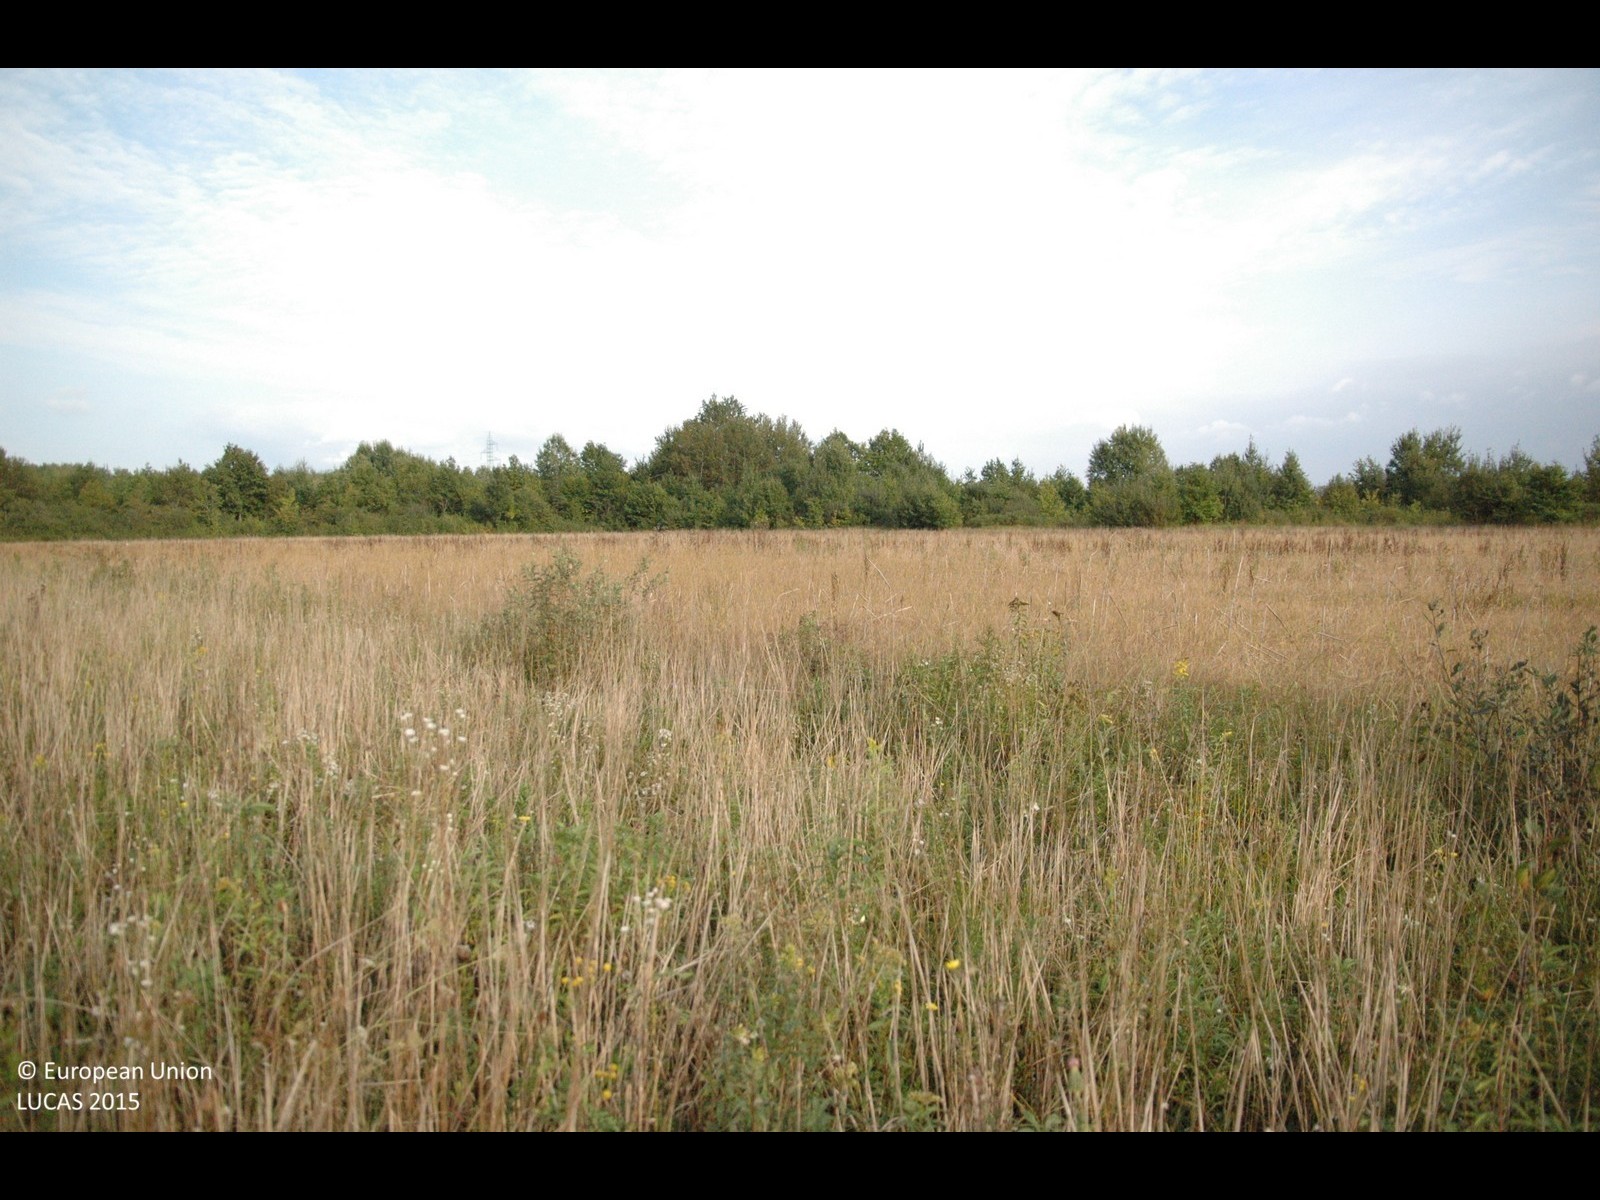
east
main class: Grassland
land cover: Grassland without tree/shrub cover
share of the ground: > 75 %
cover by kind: herbaceous plants 100 %
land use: Agriculture (excluding fallow land and kitchen gardens)
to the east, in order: Grassland without tree/shrub cover; Broadleaved woodland
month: October
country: HR
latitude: 45.5549
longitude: 16.2362
